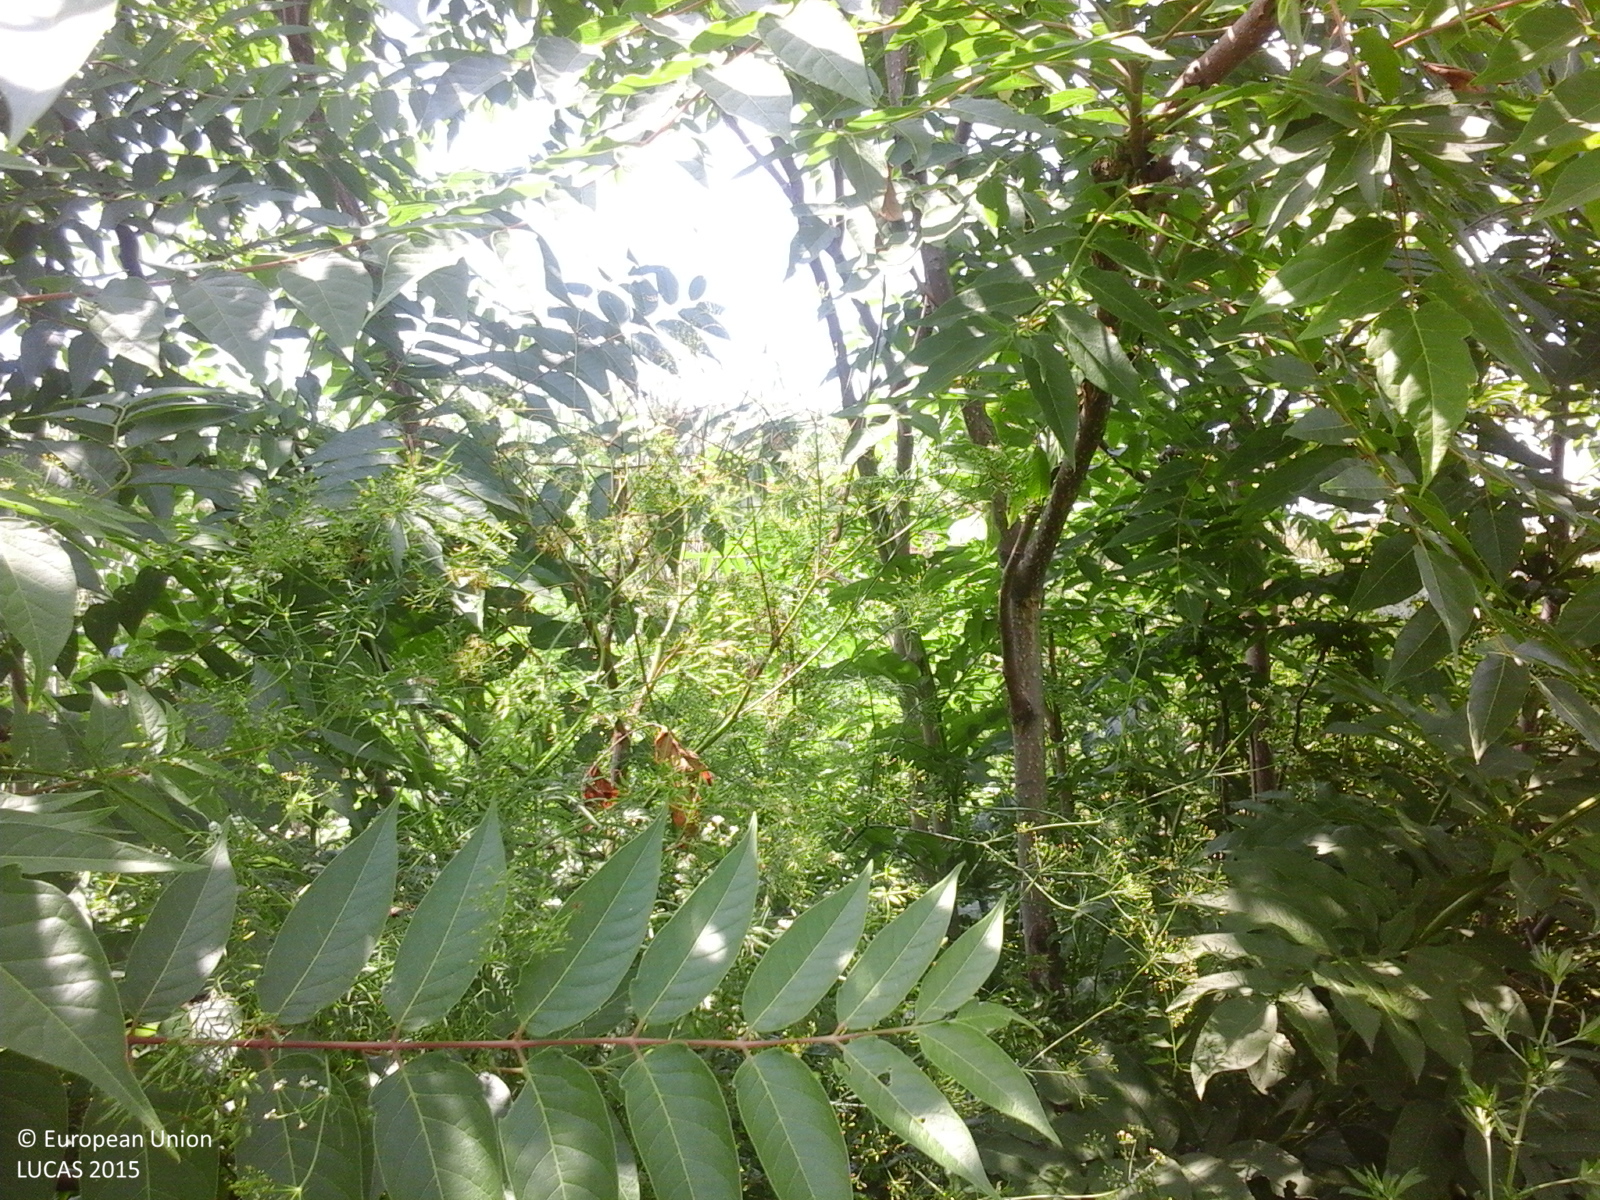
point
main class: Shrubland
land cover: Shrubland with sparse tree cover
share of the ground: > 75 %
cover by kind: shrubs 95 %, broadleaved forest trees 5 %
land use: Semi-natural and natural areas not in use
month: July
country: RO
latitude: 43.8727
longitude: 25.0210
